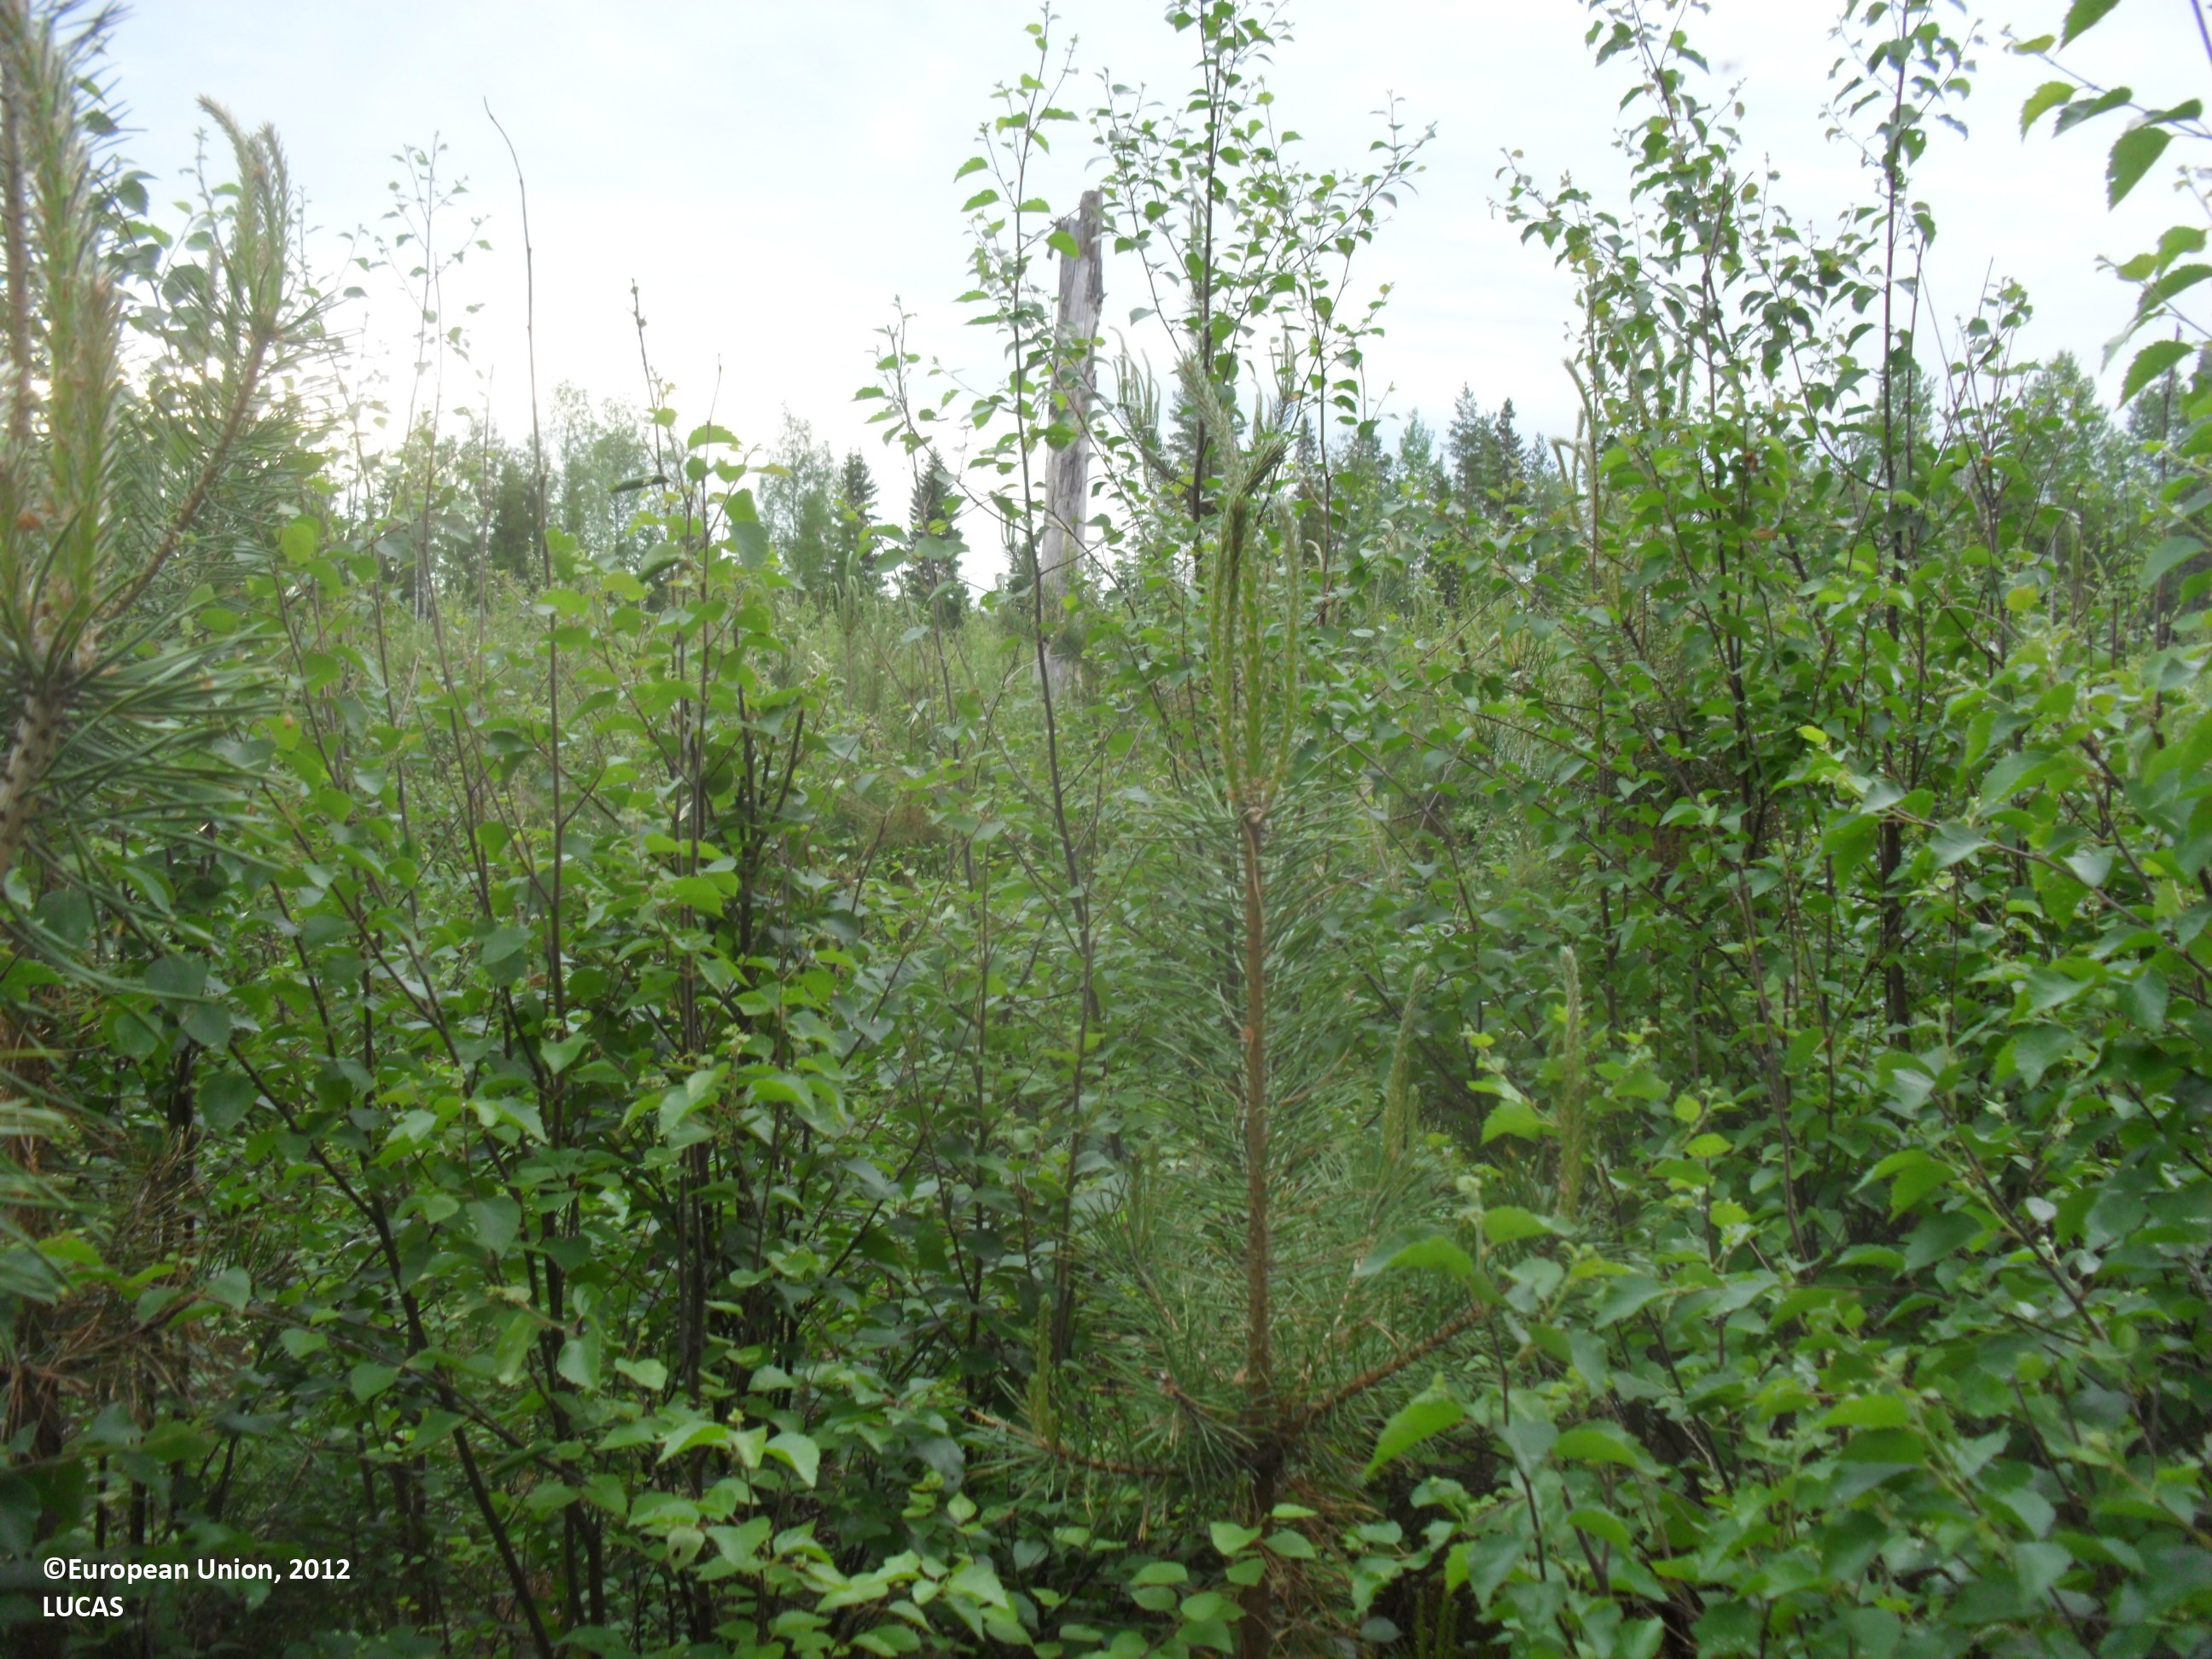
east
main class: Woodland
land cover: Other mixed woodland
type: boreal forest
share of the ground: 50 - 75 %
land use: Forestry
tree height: < 5 m
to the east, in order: Other mixed woodland; Ditches and canals; Other mixed woodland; Ditches and canals; Other mixed woodland; Pine dominated mixed woodland; Ditches and canals; Pine dominated mixed woodland; Ditches and canals; Pine dominated mixed woodland; Other mixed woodland; Spruce dominated coniferous woodland; Ditches and canals; Other mixed woodland; Pine dominated coniferous woodland; Ditches and canals; Pine dominated mixed woodland; Ditches and canals; Pine dominated coniferous woodland; Pine dominated mixed woodland
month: June
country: FI
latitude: 63.4854
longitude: 22.8822
